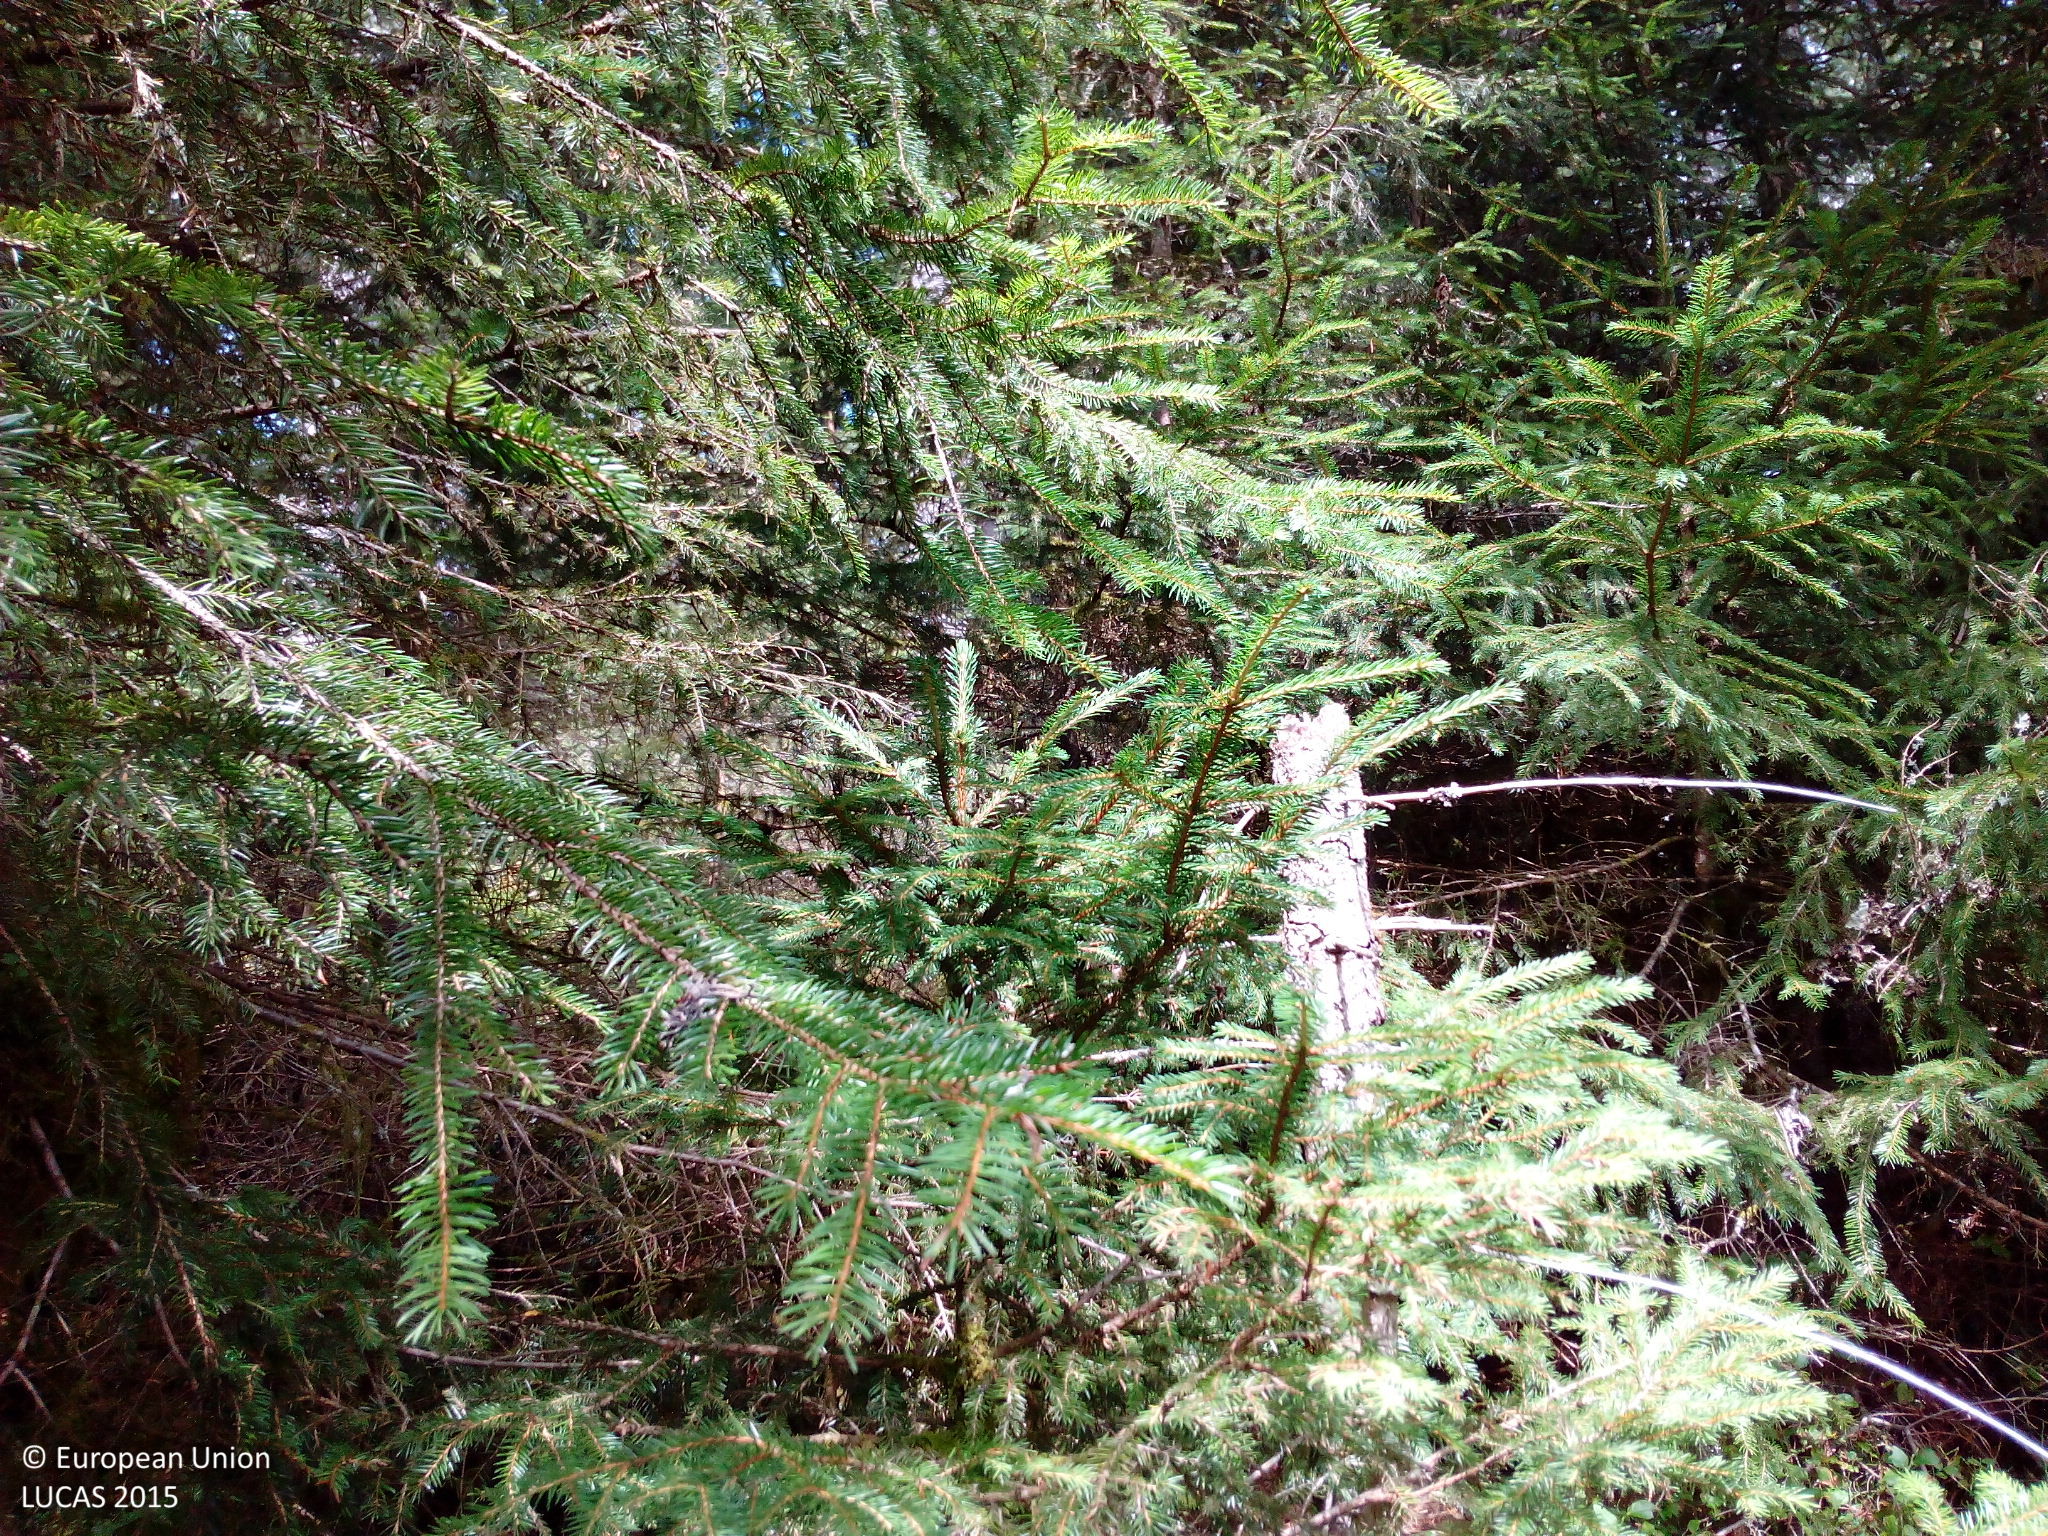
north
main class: Woodland
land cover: Spruce dominated coniferous woodland
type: hemiboreal forest and nemoral coniferous forest and mixed broadleaved-coniferous forest
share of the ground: > 75 %
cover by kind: coniferous forest trees 80 %, shrubs 10 %, lichens and mosses 10 %
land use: Semi-natural and natural areas not in use
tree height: > 5 m
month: August
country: DE
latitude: 47.7768
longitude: 8.1996
